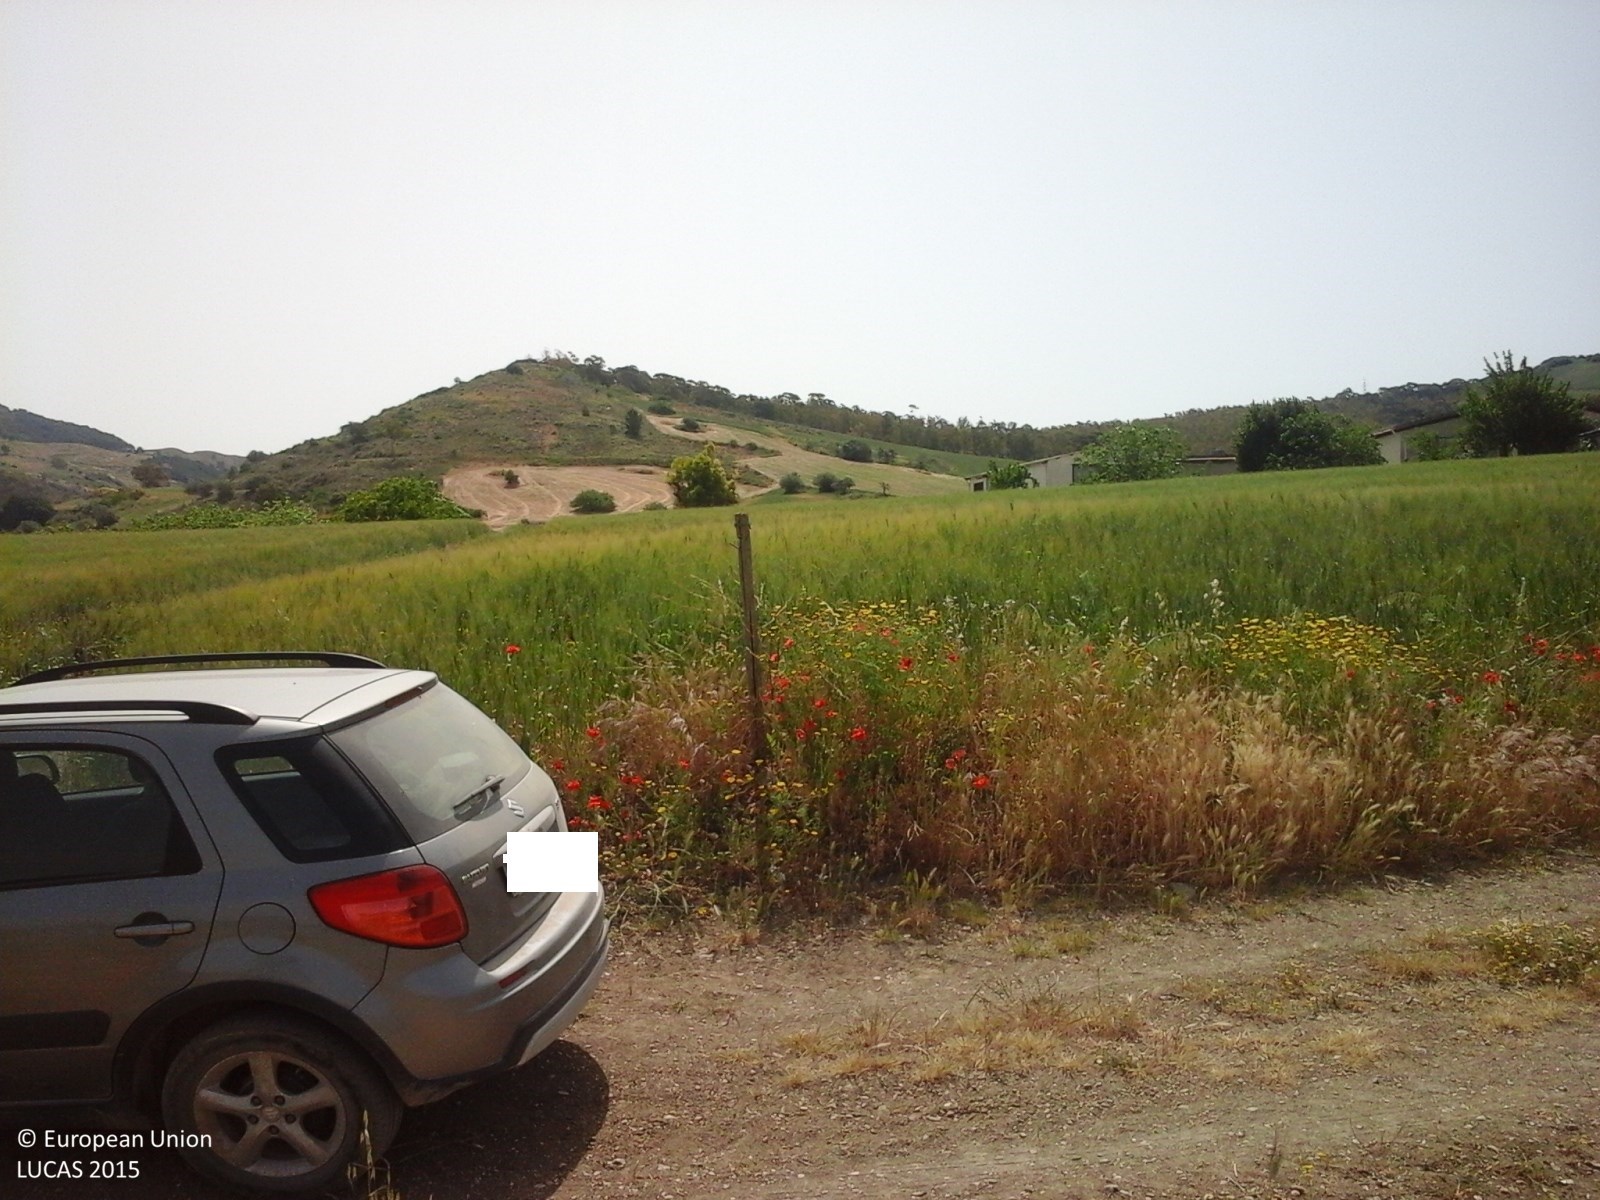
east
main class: Cropland
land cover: Durum wheat
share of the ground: > 75 %
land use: Agriculture (excluding fallow land and kitchen gardens)
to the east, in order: Durum wheat; Grass margins; Tracks; Grass margins; Durum wheat; Nuts trees
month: May
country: IT
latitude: 37.5032
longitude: 13.9185
